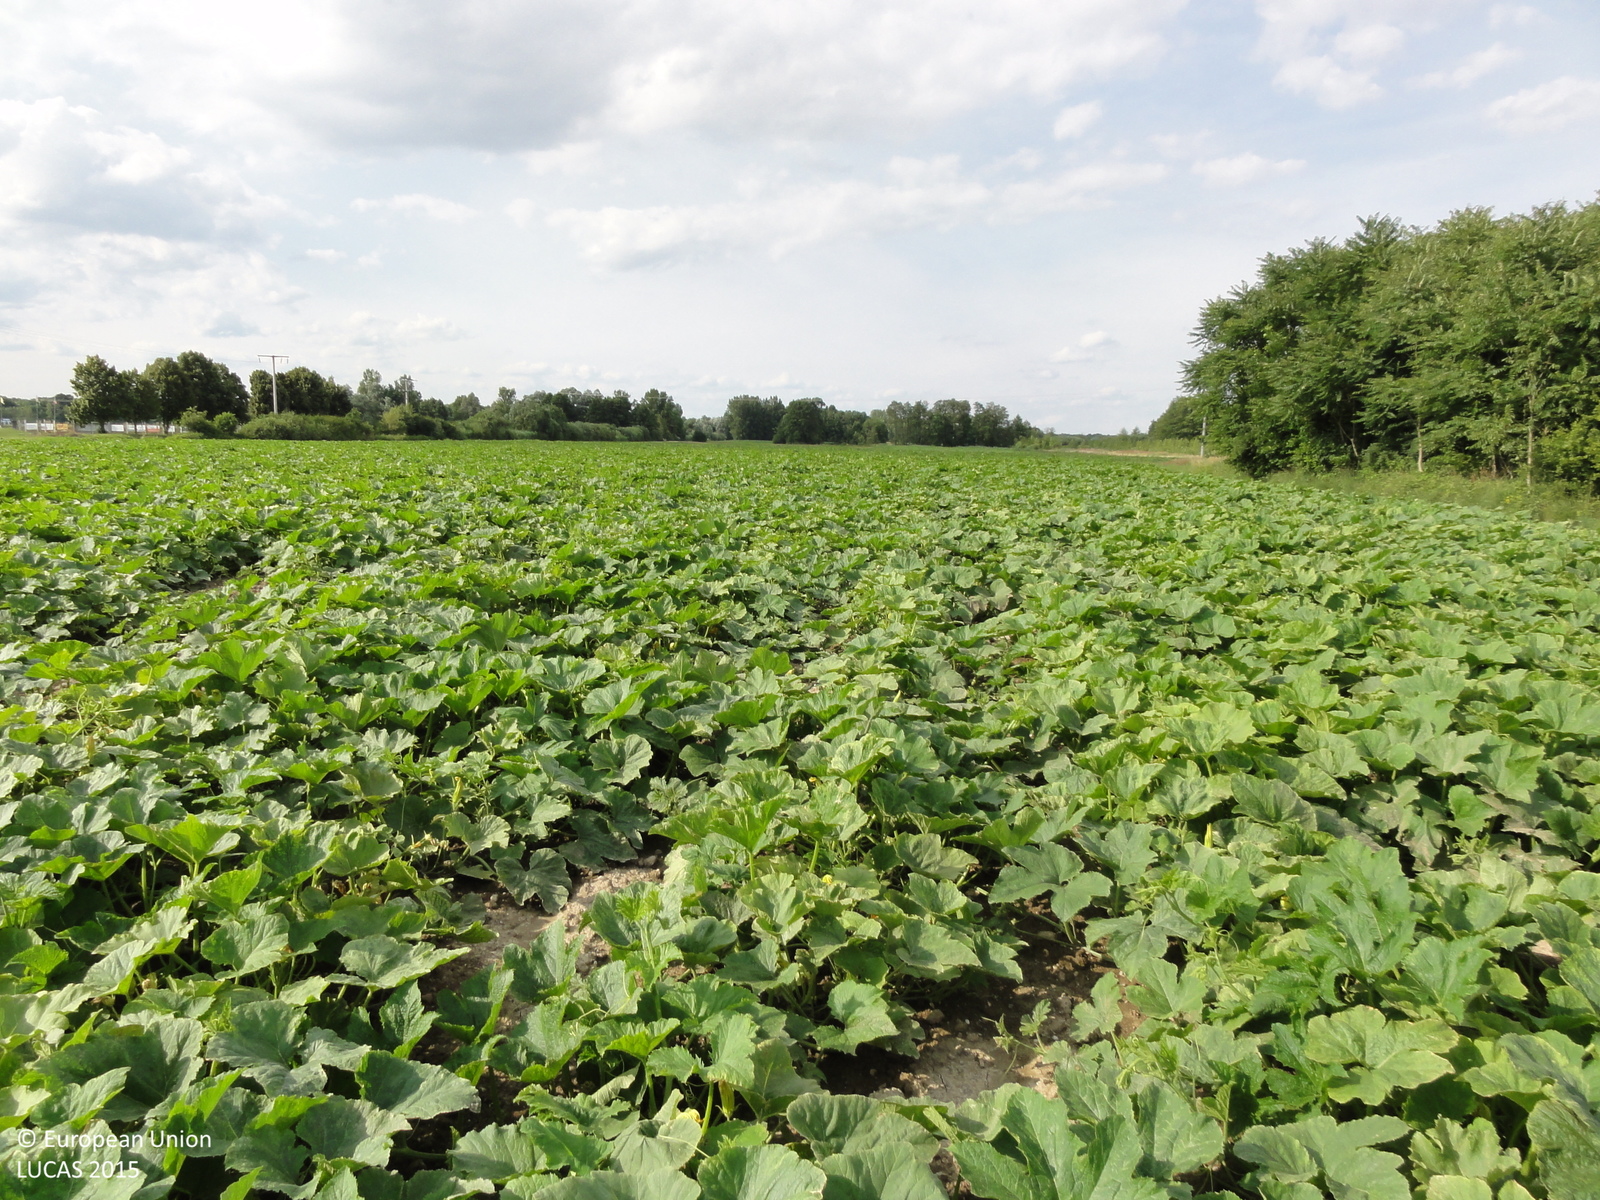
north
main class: Cropland
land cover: Other fibre and oleaginous crops
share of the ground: > 75 %
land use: Agriculture (excluding fallow land and kitchen gardens)
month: June
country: SI
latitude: 46.5566
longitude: 16.4055
